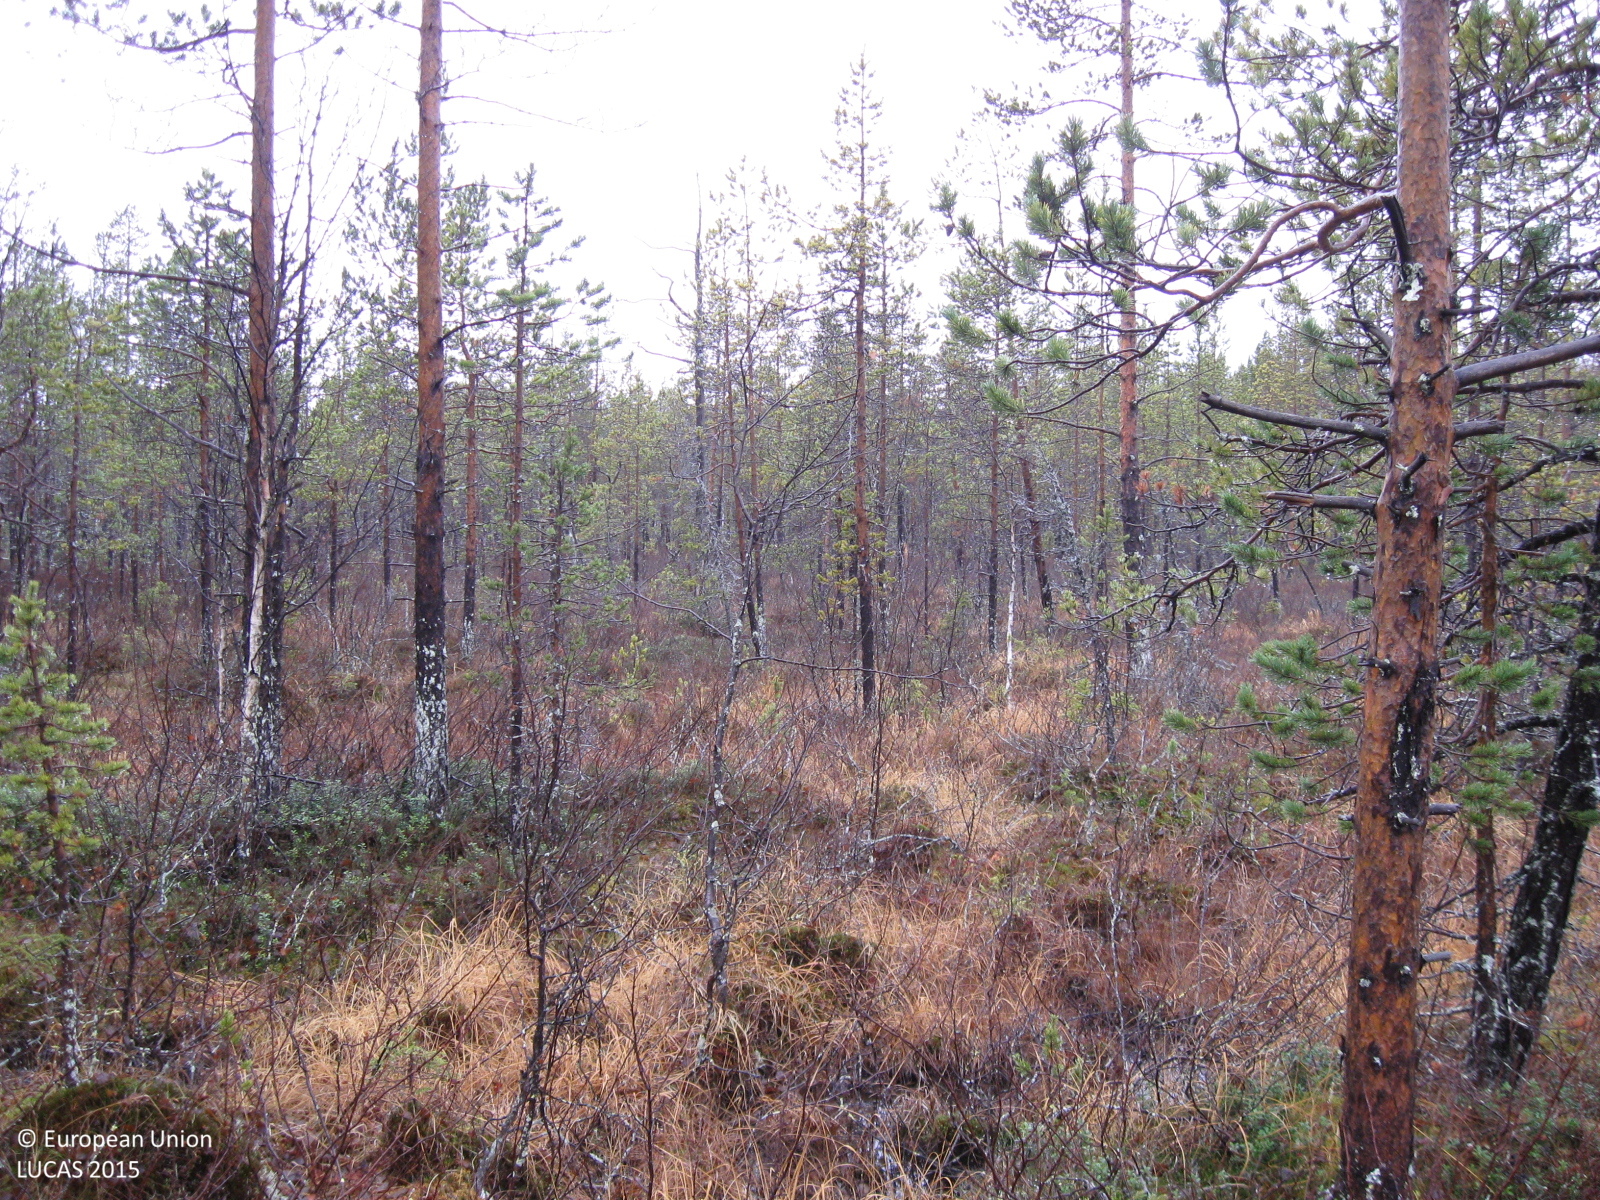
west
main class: Woodland
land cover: Pine dominated mixed woodland
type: mire and swamp forests
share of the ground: 50 - 75 %
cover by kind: coniferous forest trees 40 %, shrubs 25 %, broadleaved forest trees 20 %, herbaceous plants 10 %, lichens and mosses 5 %
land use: Forestry
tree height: > 5 m
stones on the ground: < 10 %
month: October
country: SE
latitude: 66.5738
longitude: 21.0258
